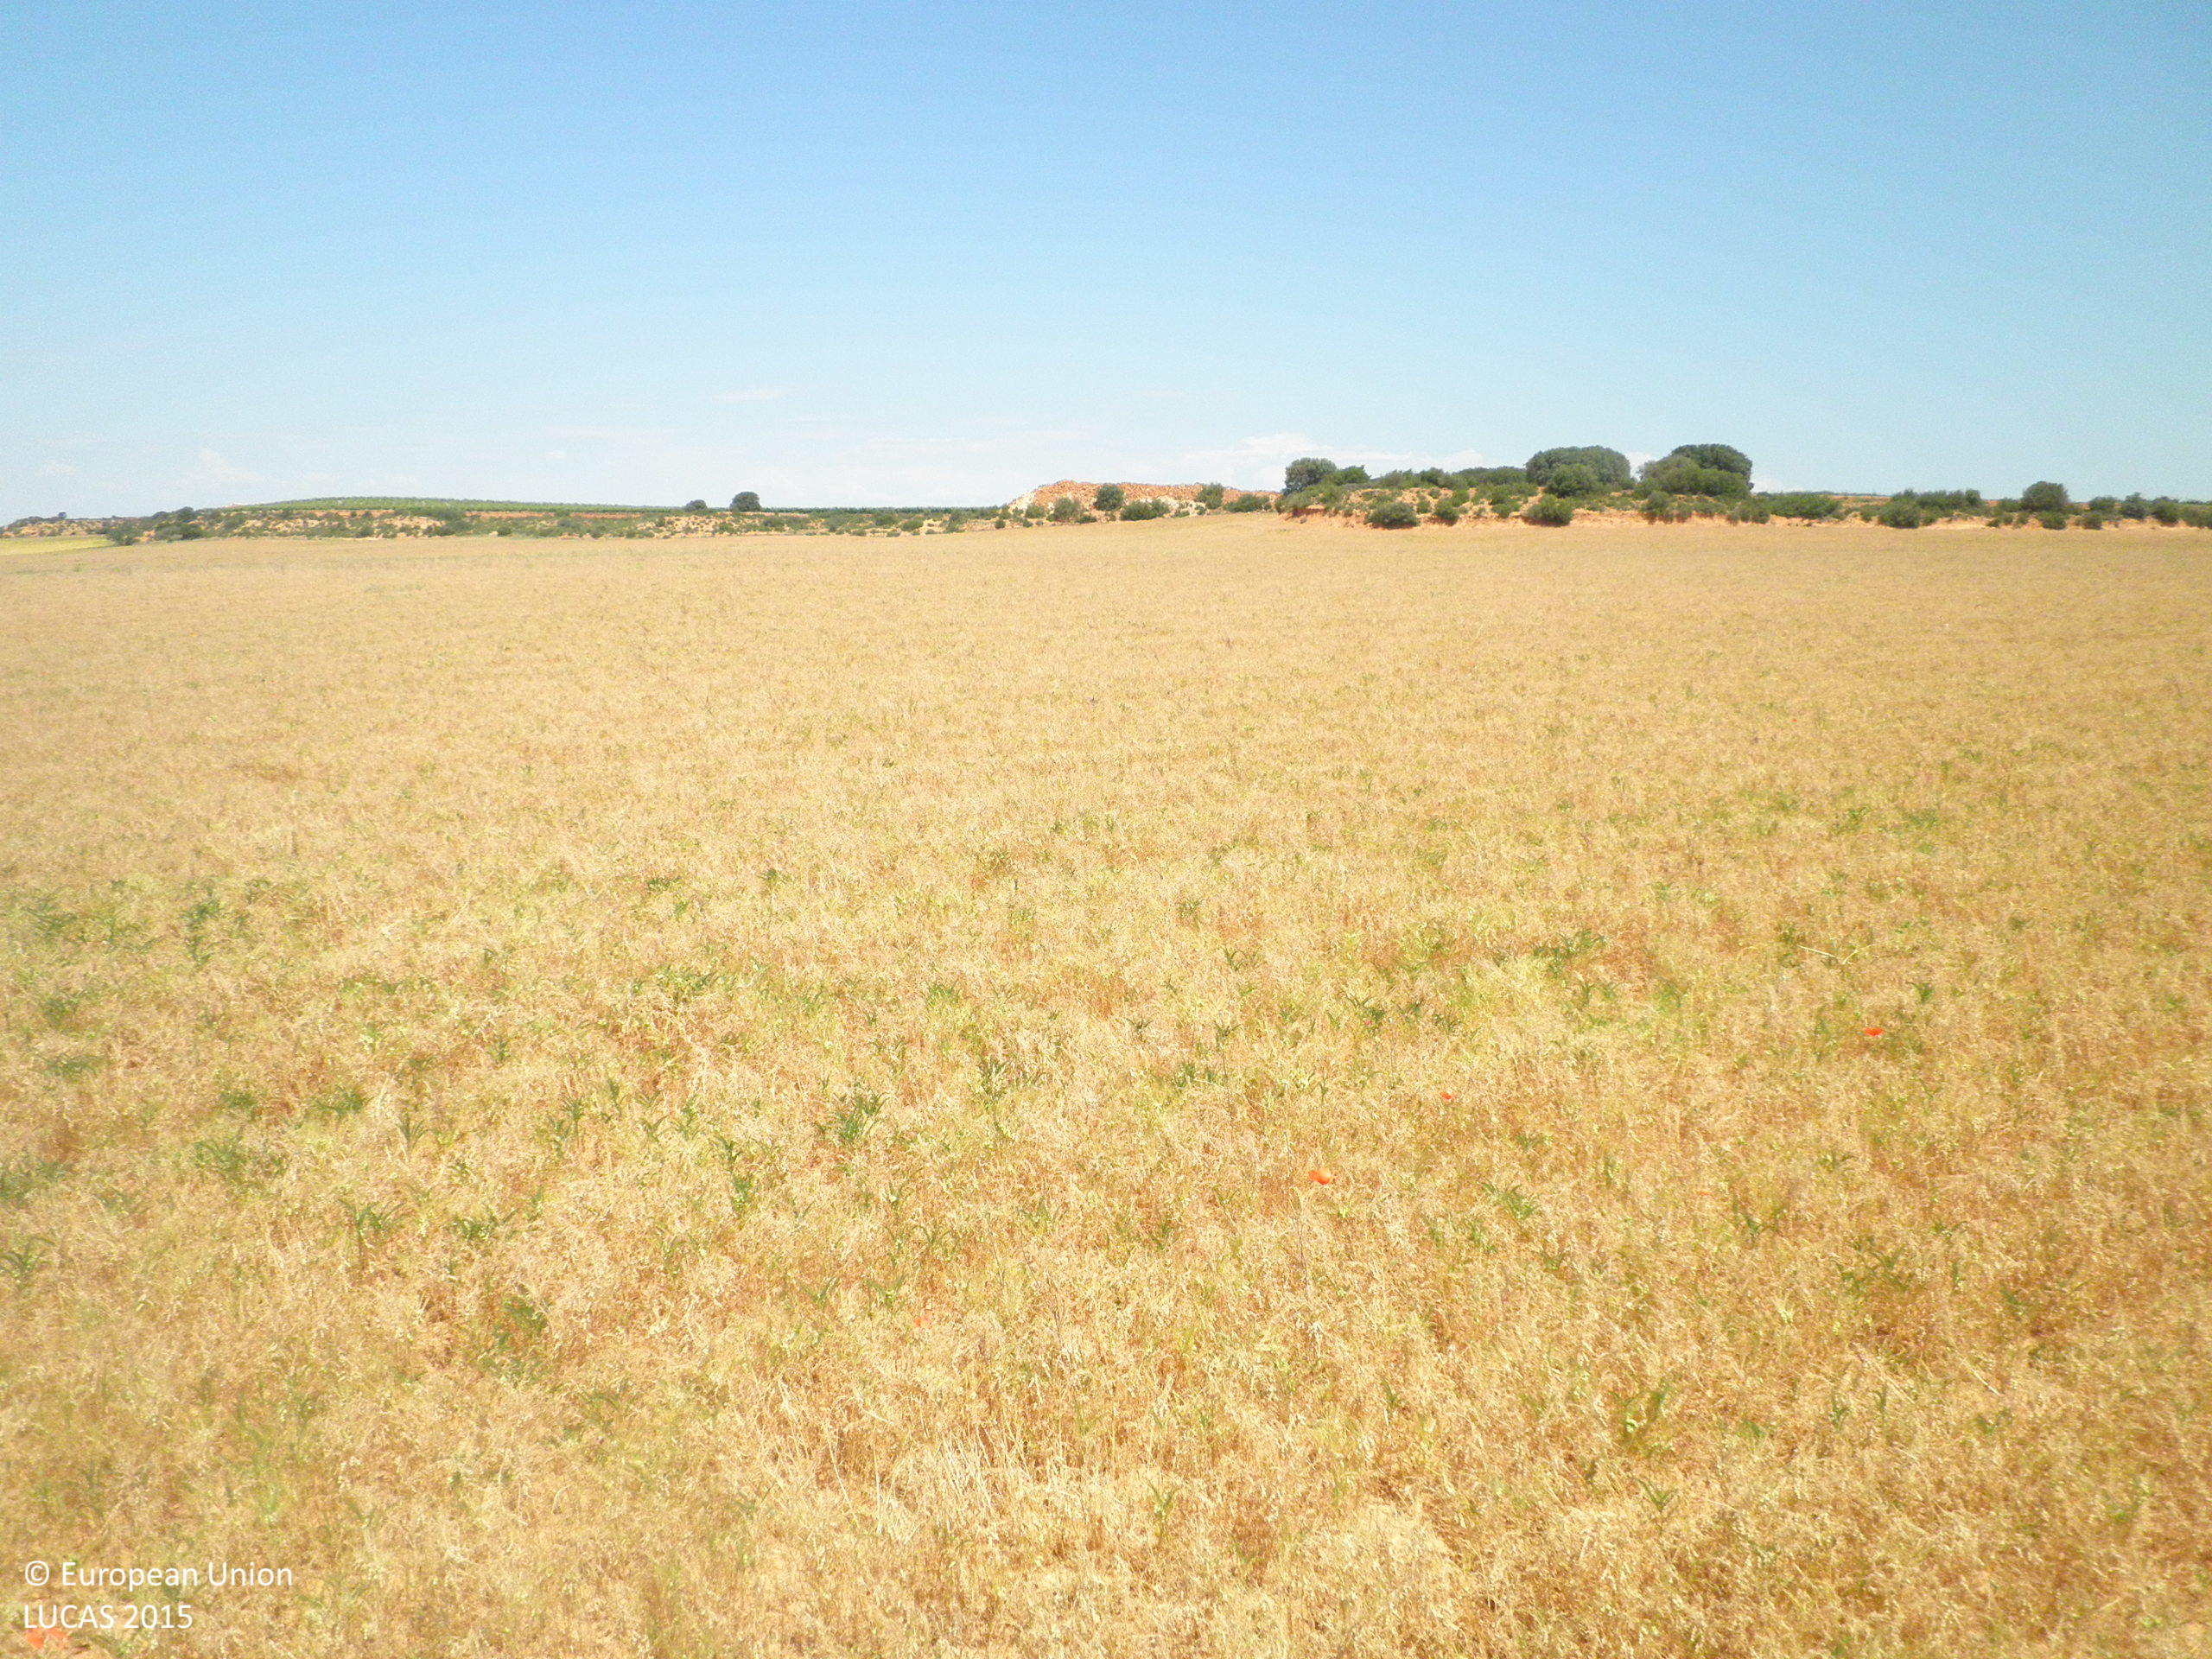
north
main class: Cropland
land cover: Dry pulses
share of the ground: > 75 %
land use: Agriculture (excluding fallow land and kitchen gardens)
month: June
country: ES
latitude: 39.4224
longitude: -1.8189
